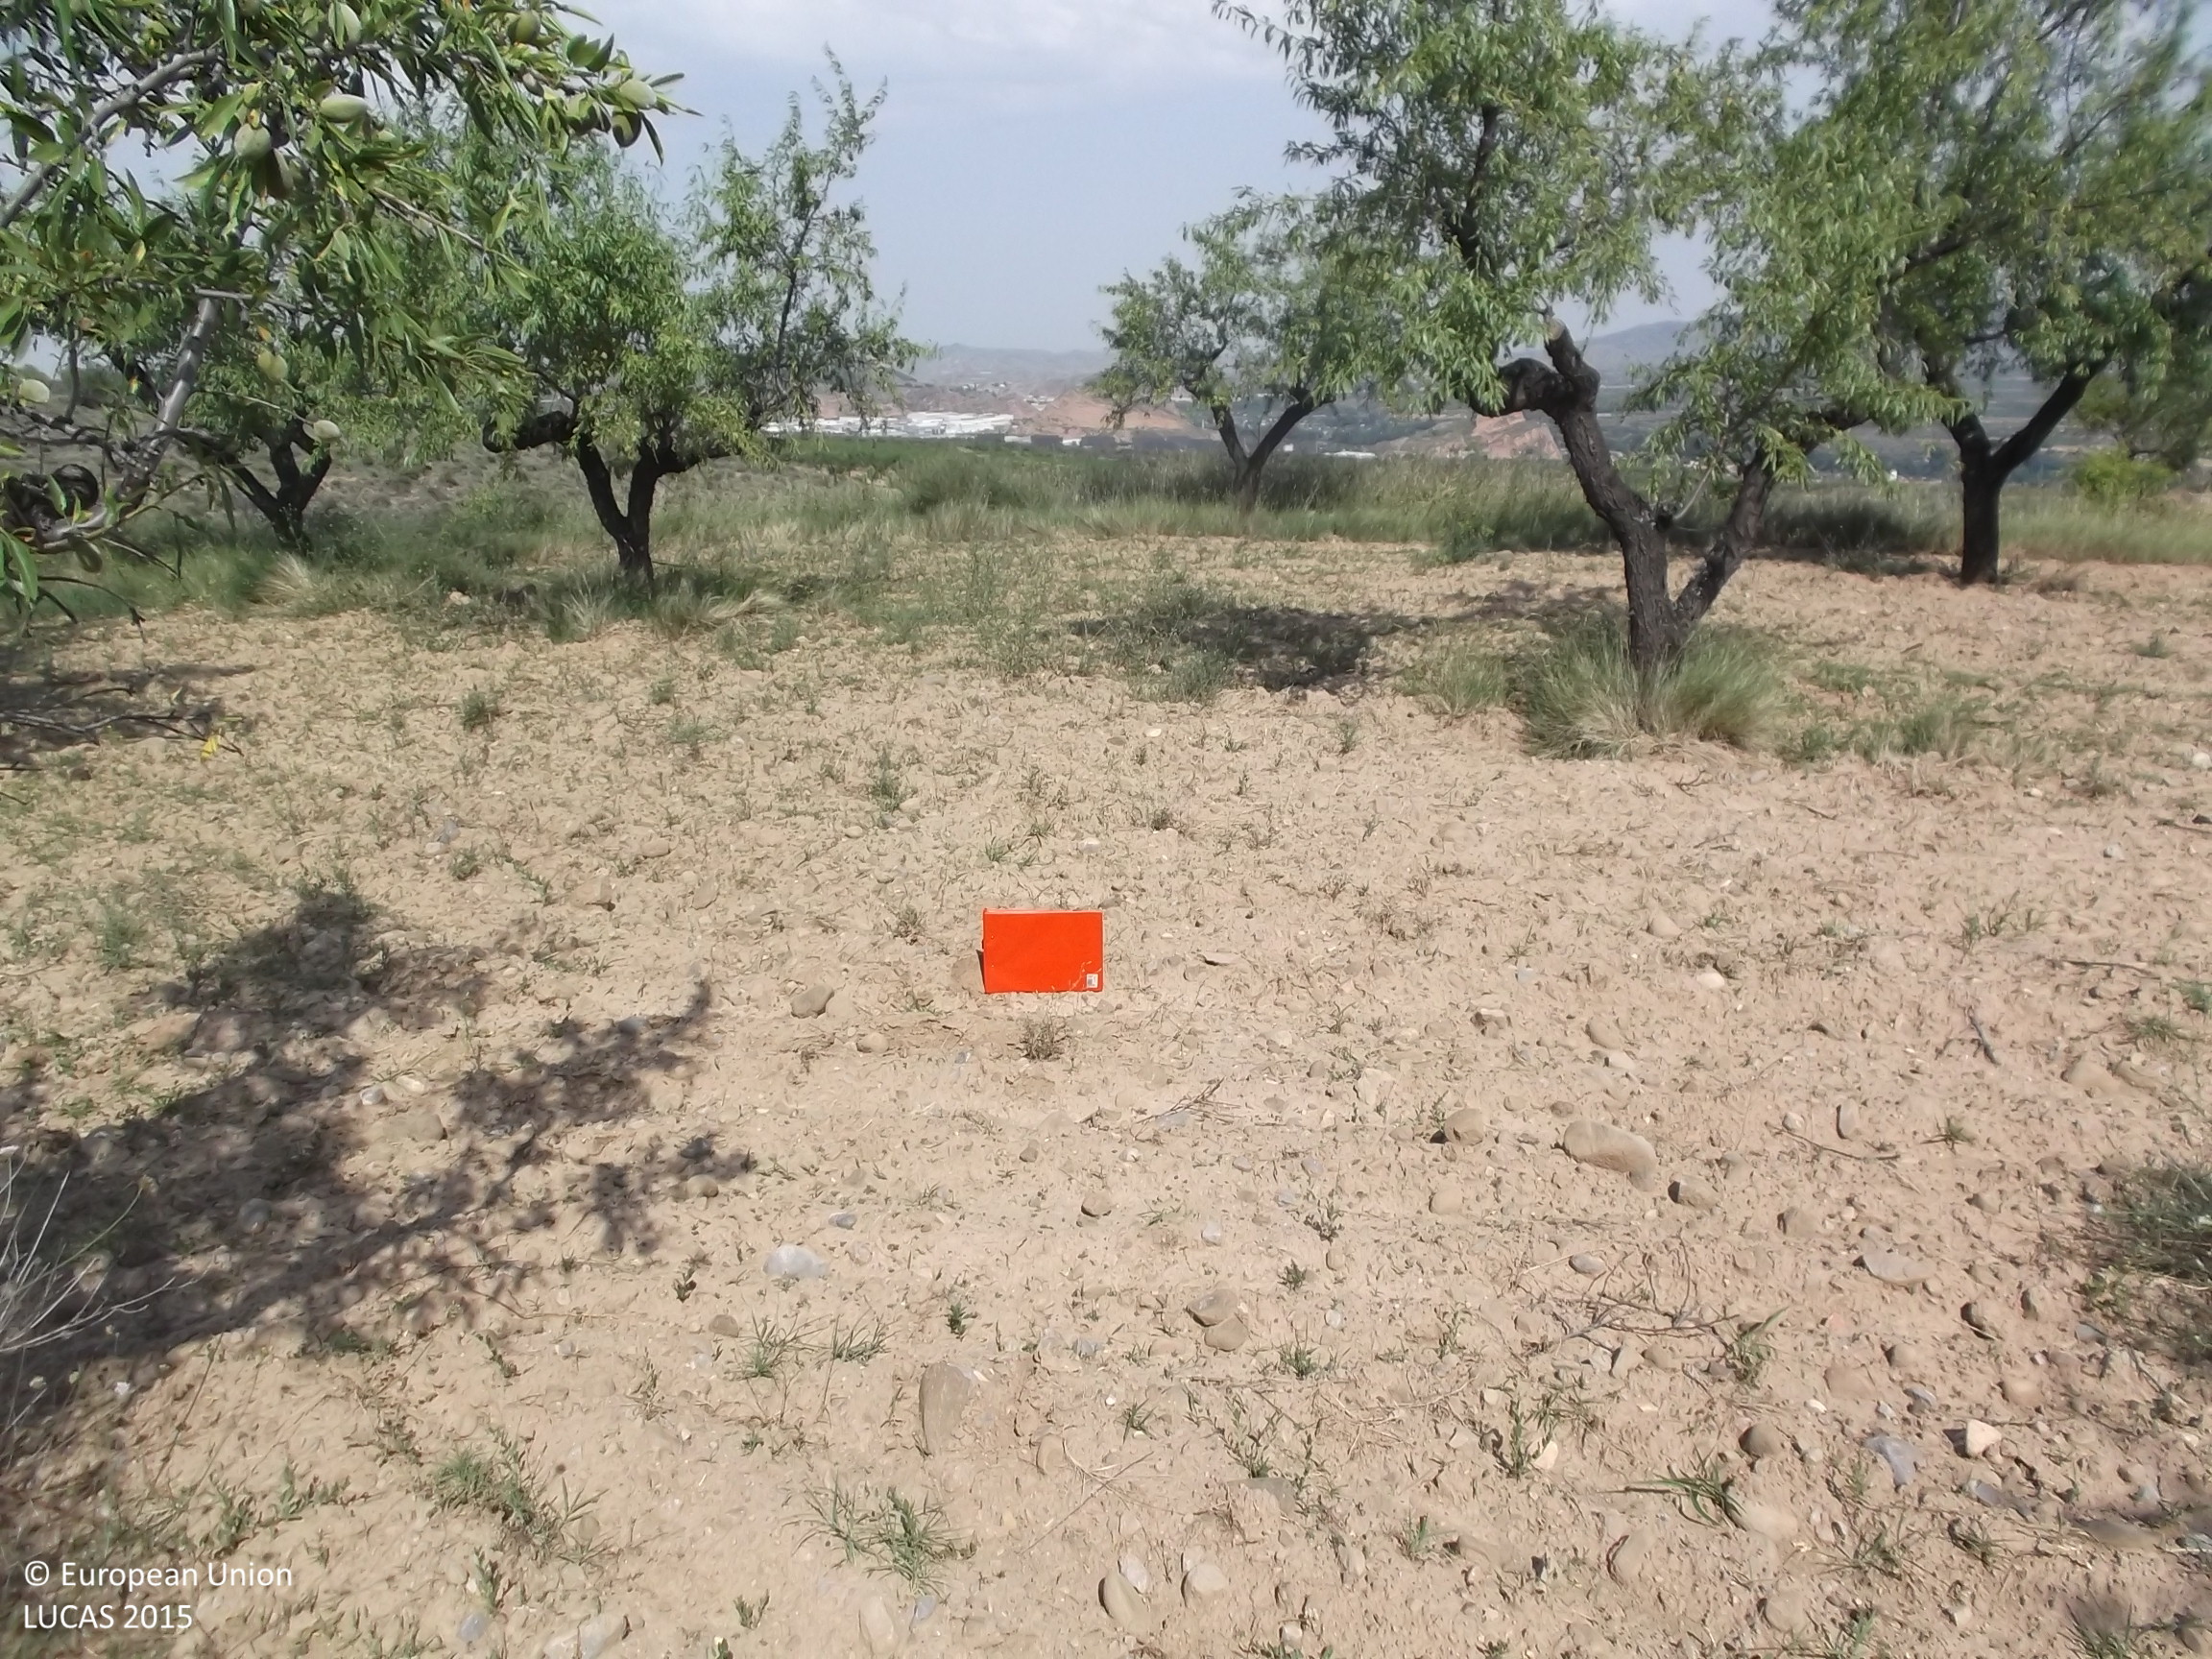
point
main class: Cropland
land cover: Nuts trees
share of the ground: 10 - 25 %
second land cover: Other bare soil
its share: > 75 %
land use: Agriculture (excluding fallow land and kitchen gardens)
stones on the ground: 10 - 25 %
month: July
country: ES
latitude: 42.2335
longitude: -2.1196
